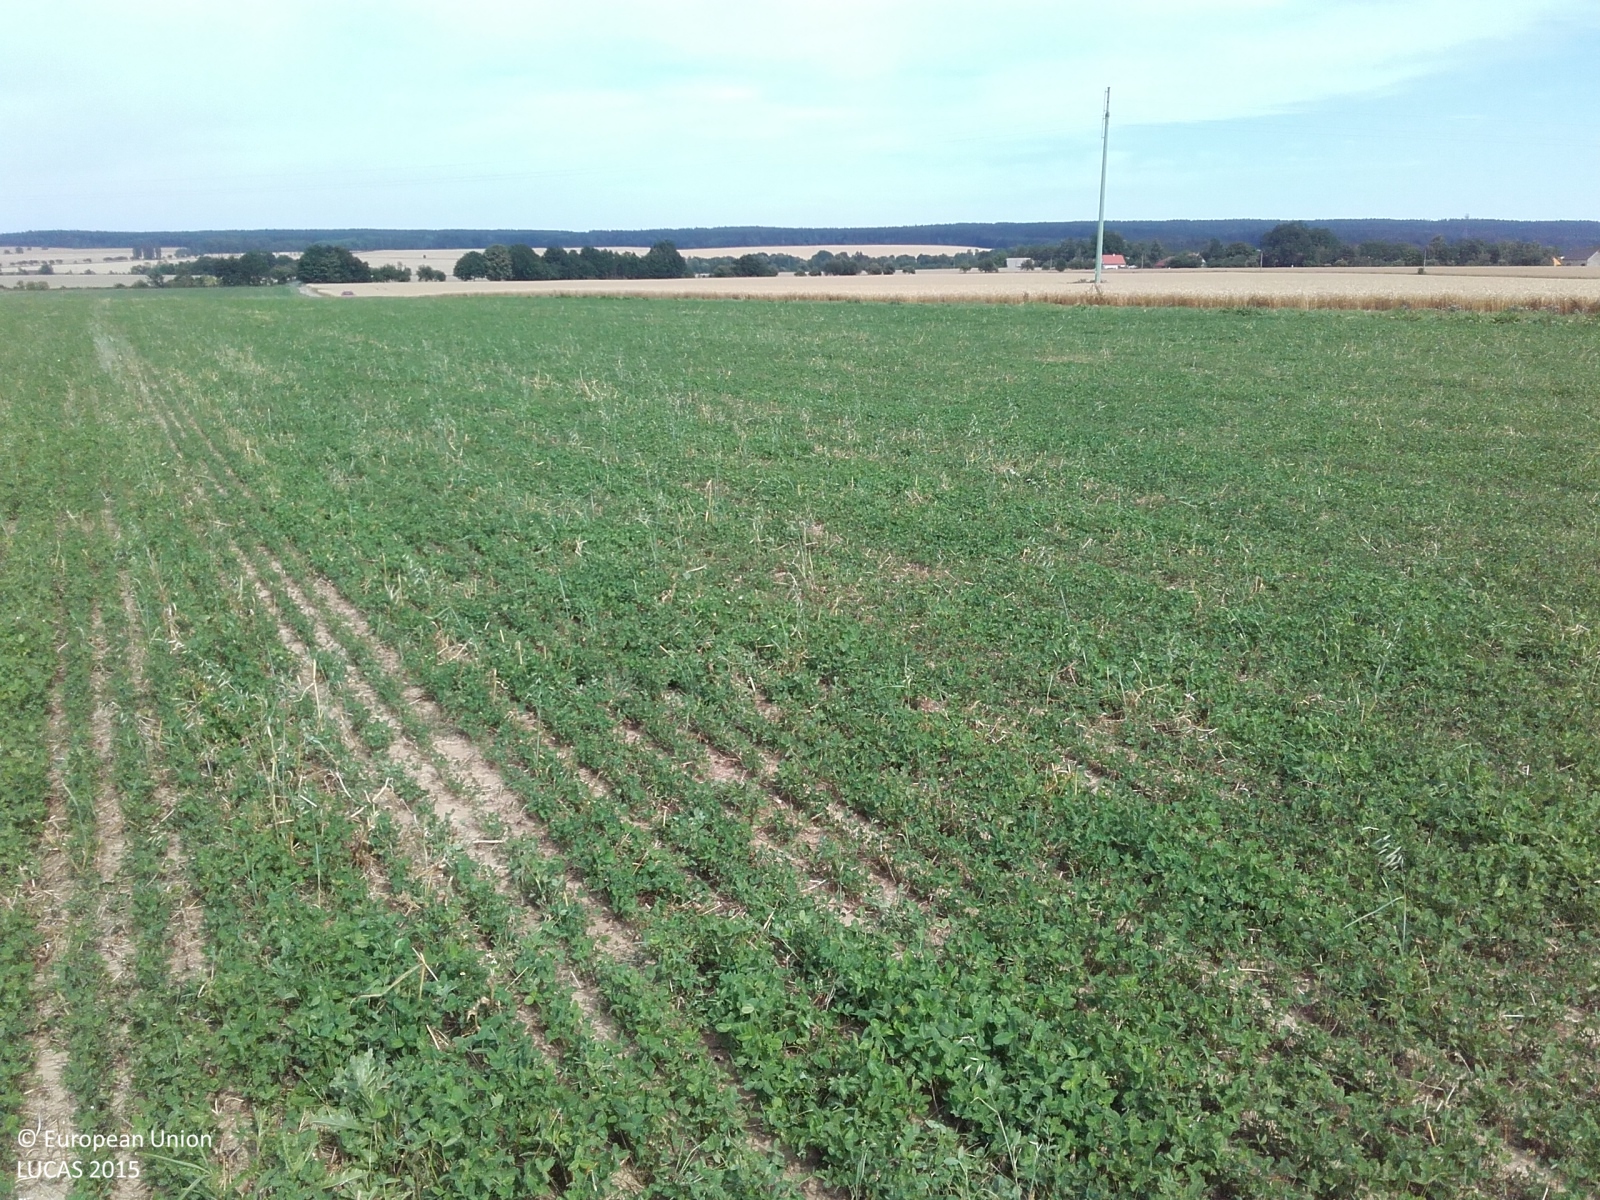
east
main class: Cropland
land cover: Clovers
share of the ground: > 75 %
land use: Agriculture (excluding fallow land and kitchen gardens)
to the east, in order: Clovers; Grassland without tree/shrub cover; Tracks; Grass margins; Common wheat; Electric lines; Common wheat
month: August
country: CZ
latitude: 49.8100
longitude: 16.3295
